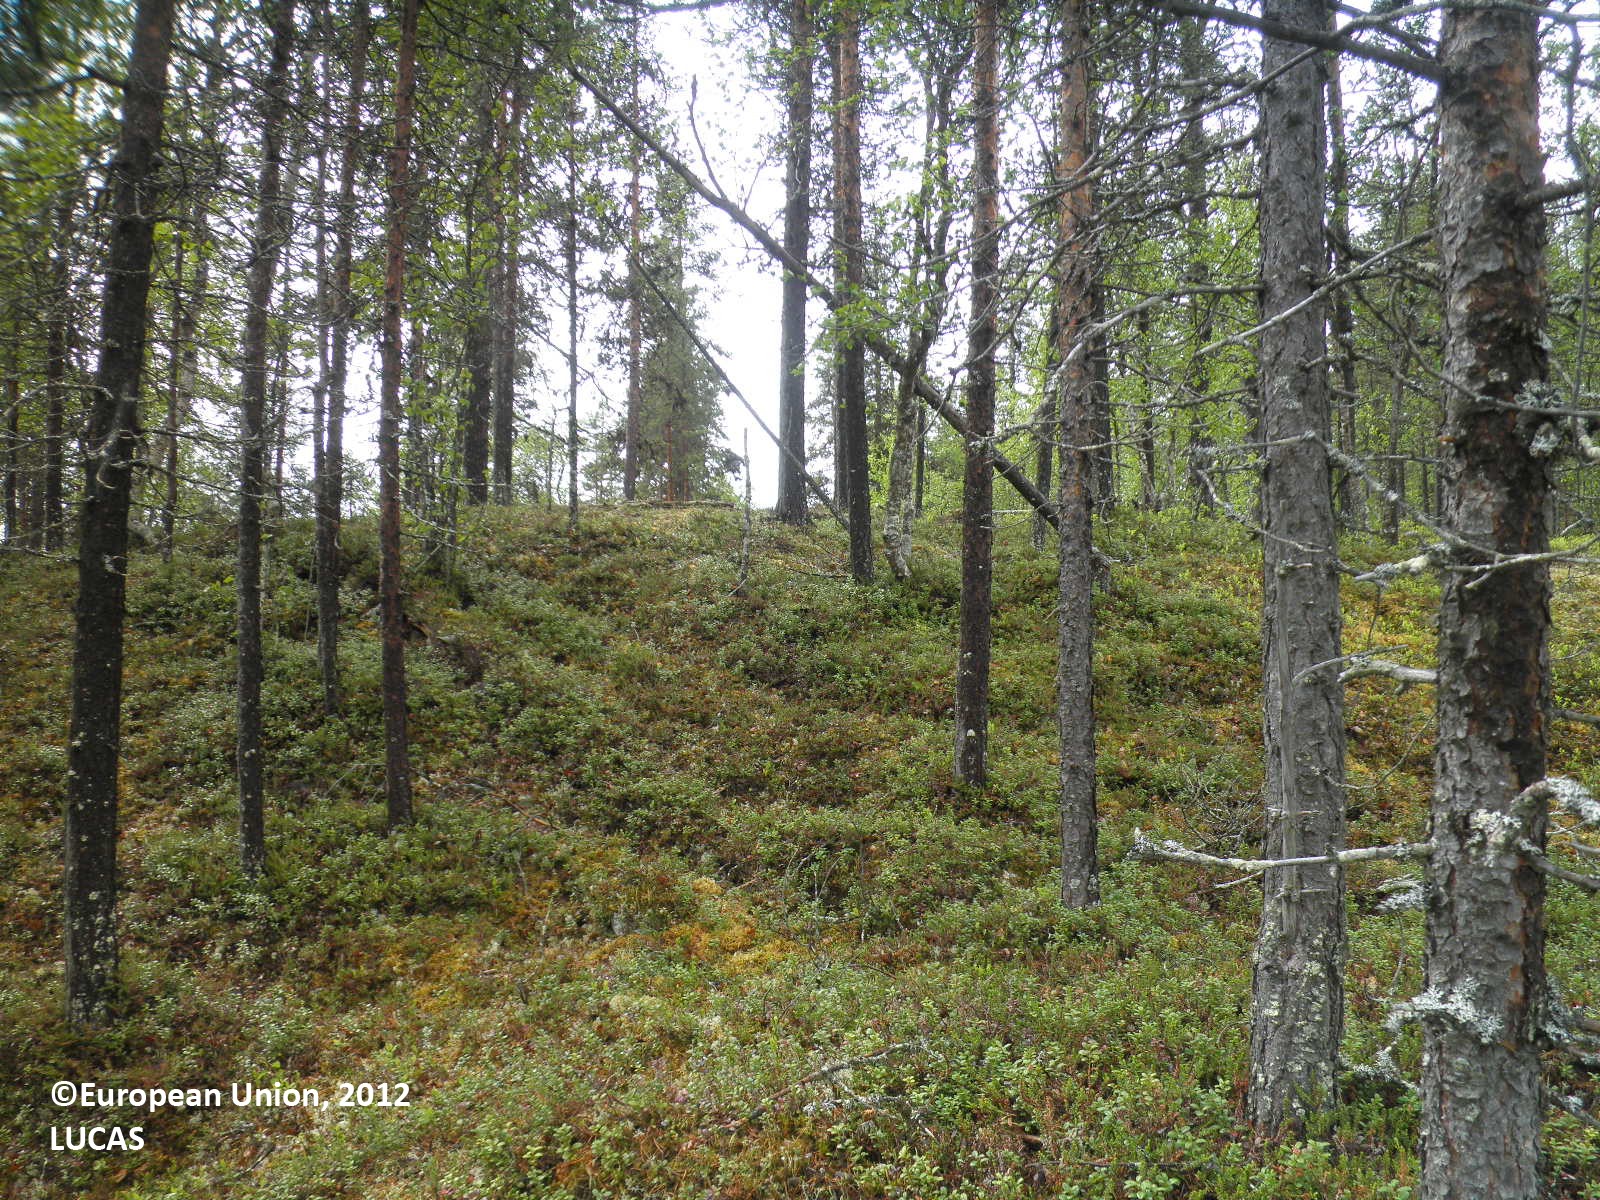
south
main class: Woodland
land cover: Pine dominated mixed woodland
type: boreal forest
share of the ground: 50 - 75 %
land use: Forestry
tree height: > 5 m
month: June
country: FI
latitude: 68.4034
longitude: 26.4391
